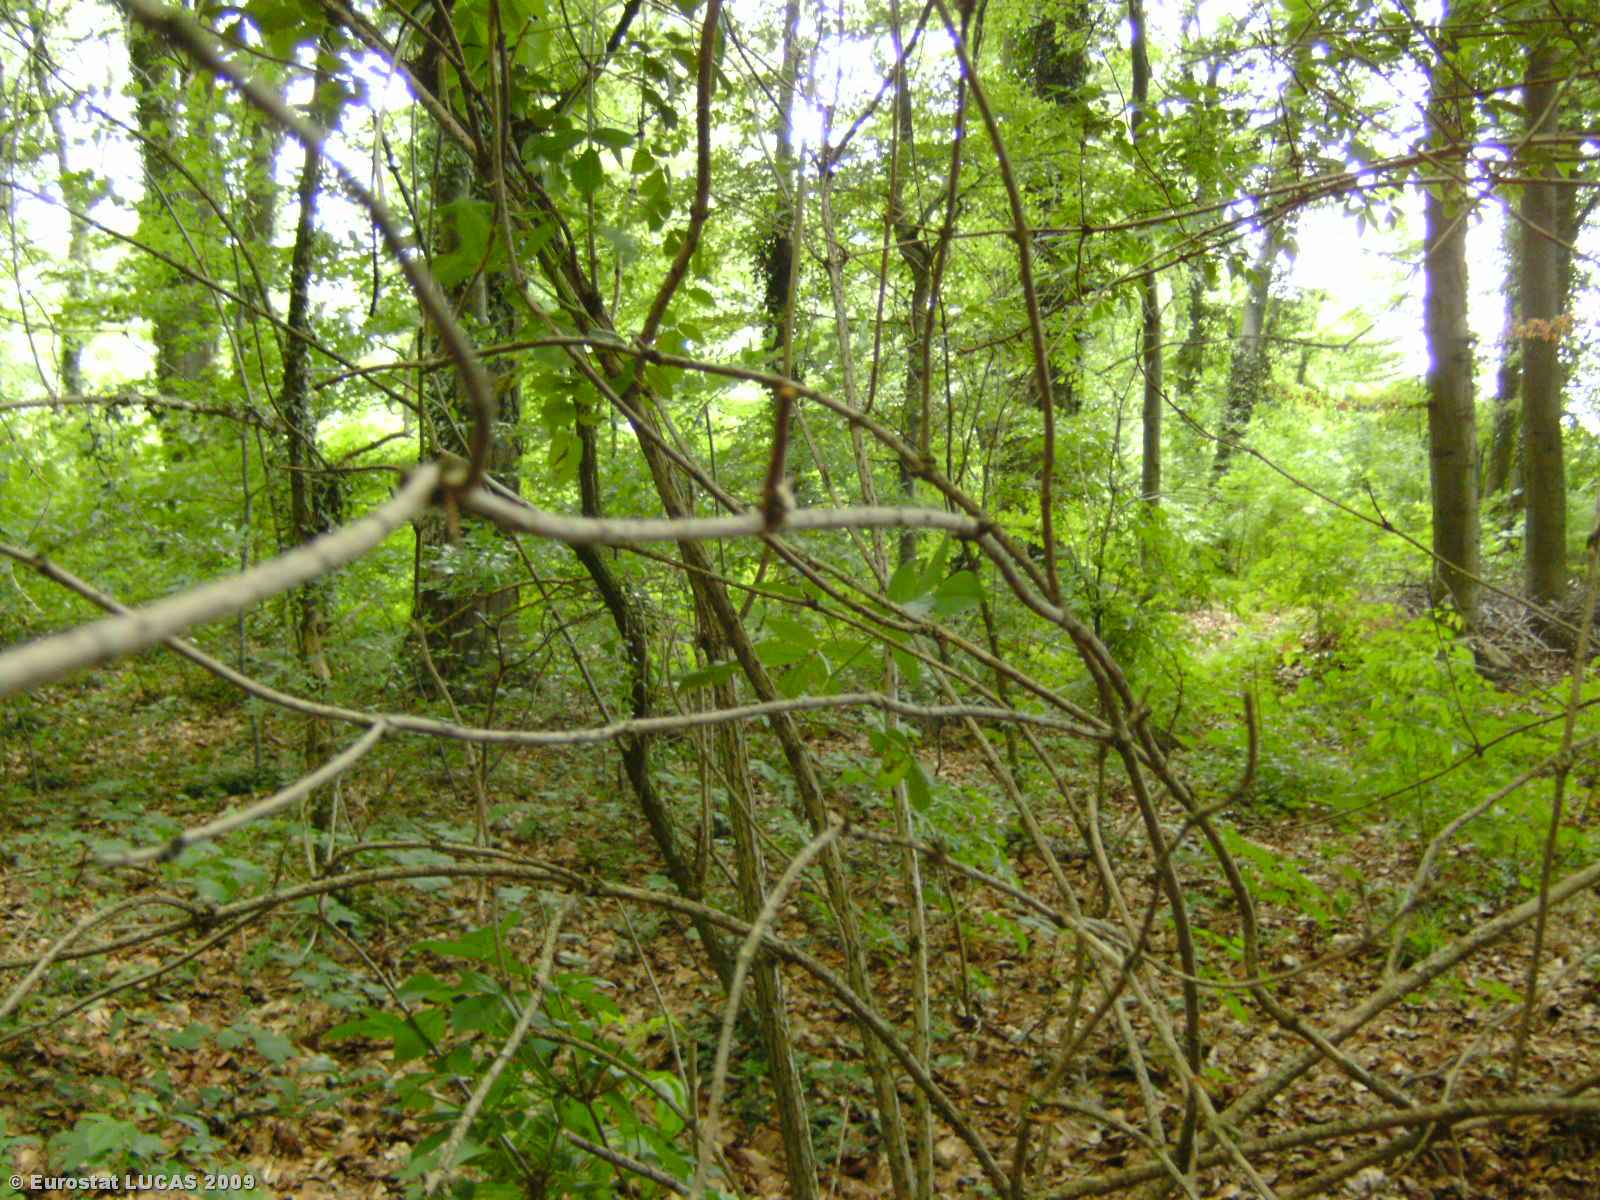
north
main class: Woodland
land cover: Broadleaved woodland
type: beech forest
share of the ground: > 75 %
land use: Forestry
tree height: > 5 m
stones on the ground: < 10 %
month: June
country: LU
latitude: 49.5637
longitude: 6.2251
